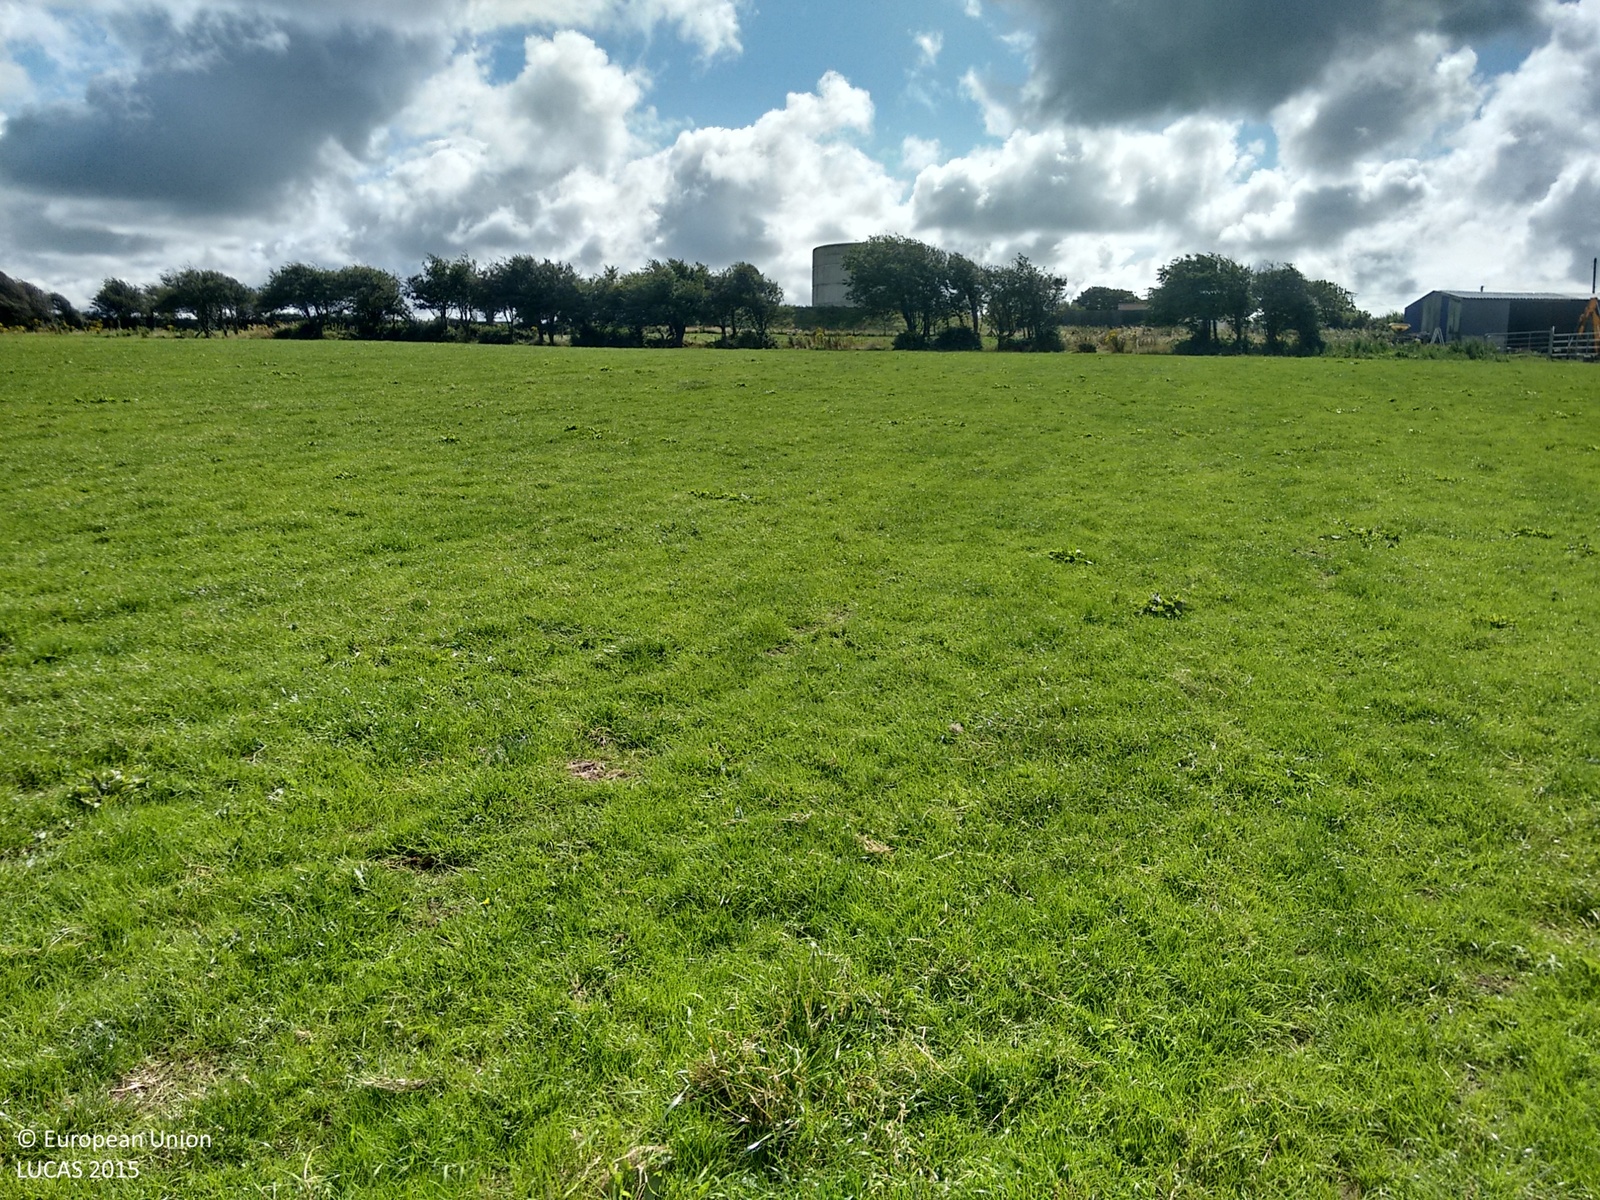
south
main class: Grassland
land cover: Grassland without tree/shrub cover
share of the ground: > 75 %
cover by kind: herbaceous plants 90 %, shrubs 5 %, unconsolidated bare surface 5 %
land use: Agriculture (excluding fallow land and kitchen gardens)
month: September
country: IE
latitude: 52.3606
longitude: -9.7593
